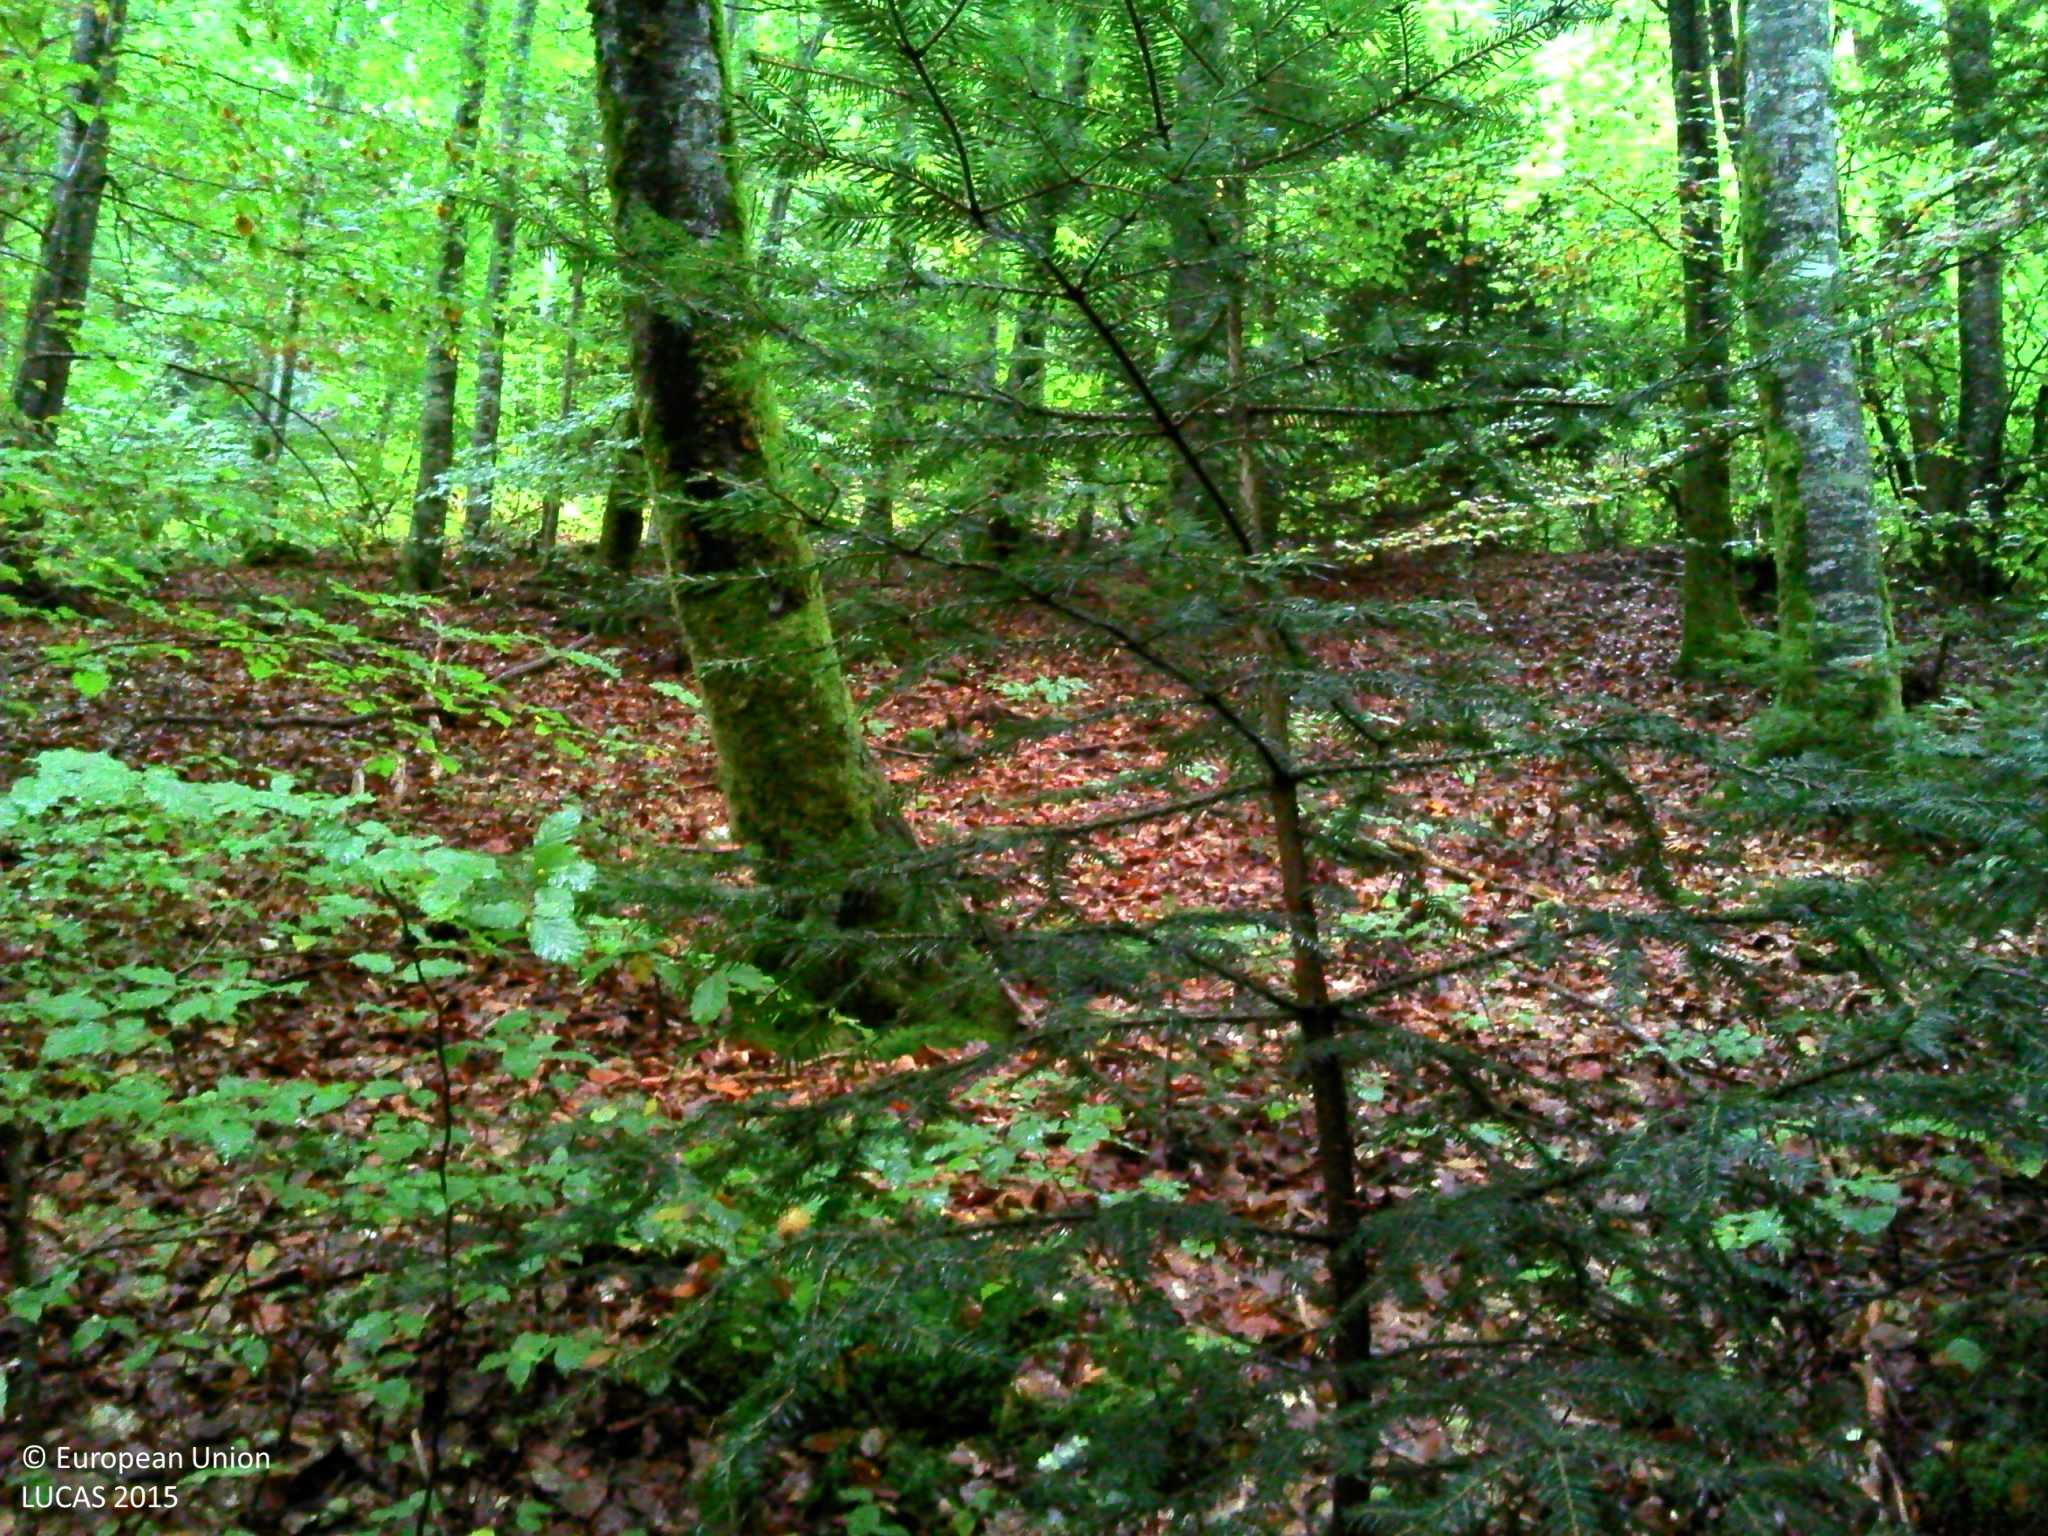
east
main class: Woodland
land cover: Broadleaved woodland
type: mountainous beech forest
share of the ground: > 75 %
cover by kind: broadleaved forest trees 80 %, coniferous forest trees 10 %, herbaceous plants 5 %, lichens and mosses 5 %
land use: Forestry
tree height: > 5 m
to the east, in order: Broadleaved woodland; Grass margins; Tracks; Grass margins; Broadleaved woodland; Other bare soil; Paved roads, cycling and walking lanes; Grass margins; Ditches and canals; Spontaneously vegetated surfaces; Fences; Broadleaved woodland; Tracks; Broadleaved woodland; Other coniferous woodland
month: October
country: FR
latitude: 45.9108
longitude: 3.6712
